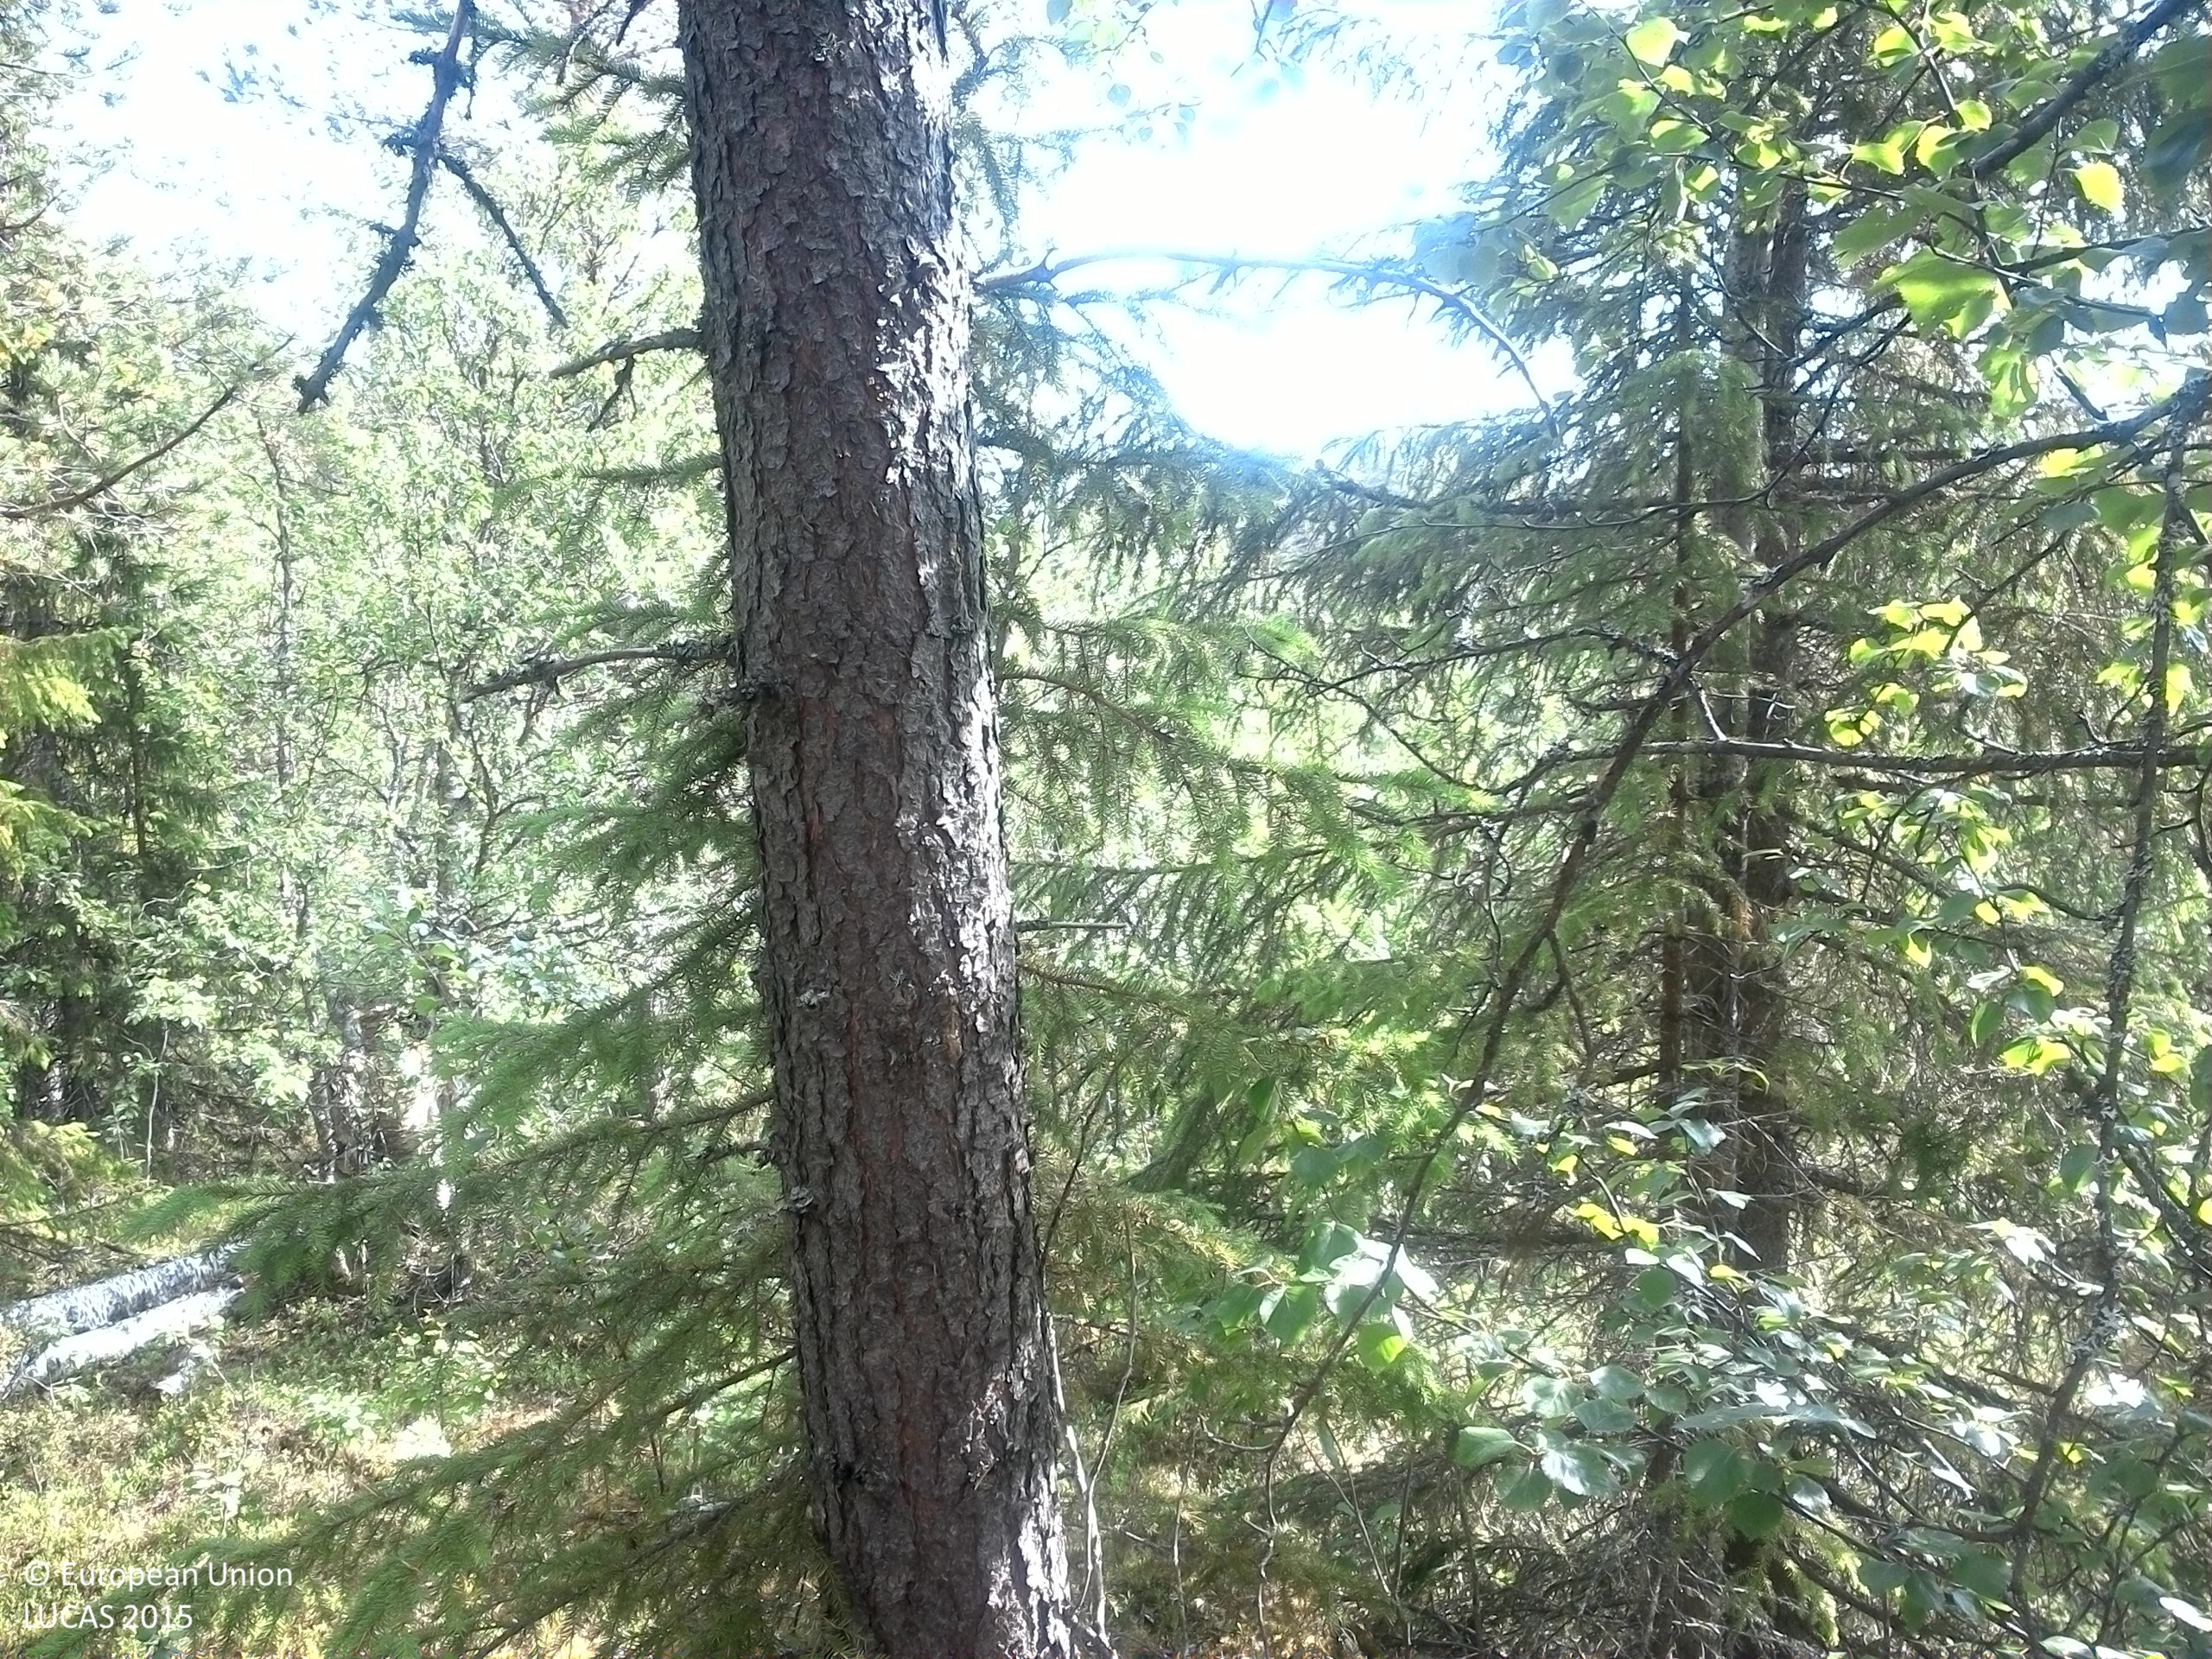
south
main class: Woodland
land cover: Other coniferous woodland
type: boreal forest
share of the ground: 50 - 75 %
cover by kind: coniferous forest trees 50 %, shrubs 25 %, broadleaved forest trees 10 %, lichens and mosses 10 %, consolidated bare surface 5 %
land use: Forestry
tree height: > 5 m
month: July
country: SE
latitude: 64.7109
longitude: 15.7379
